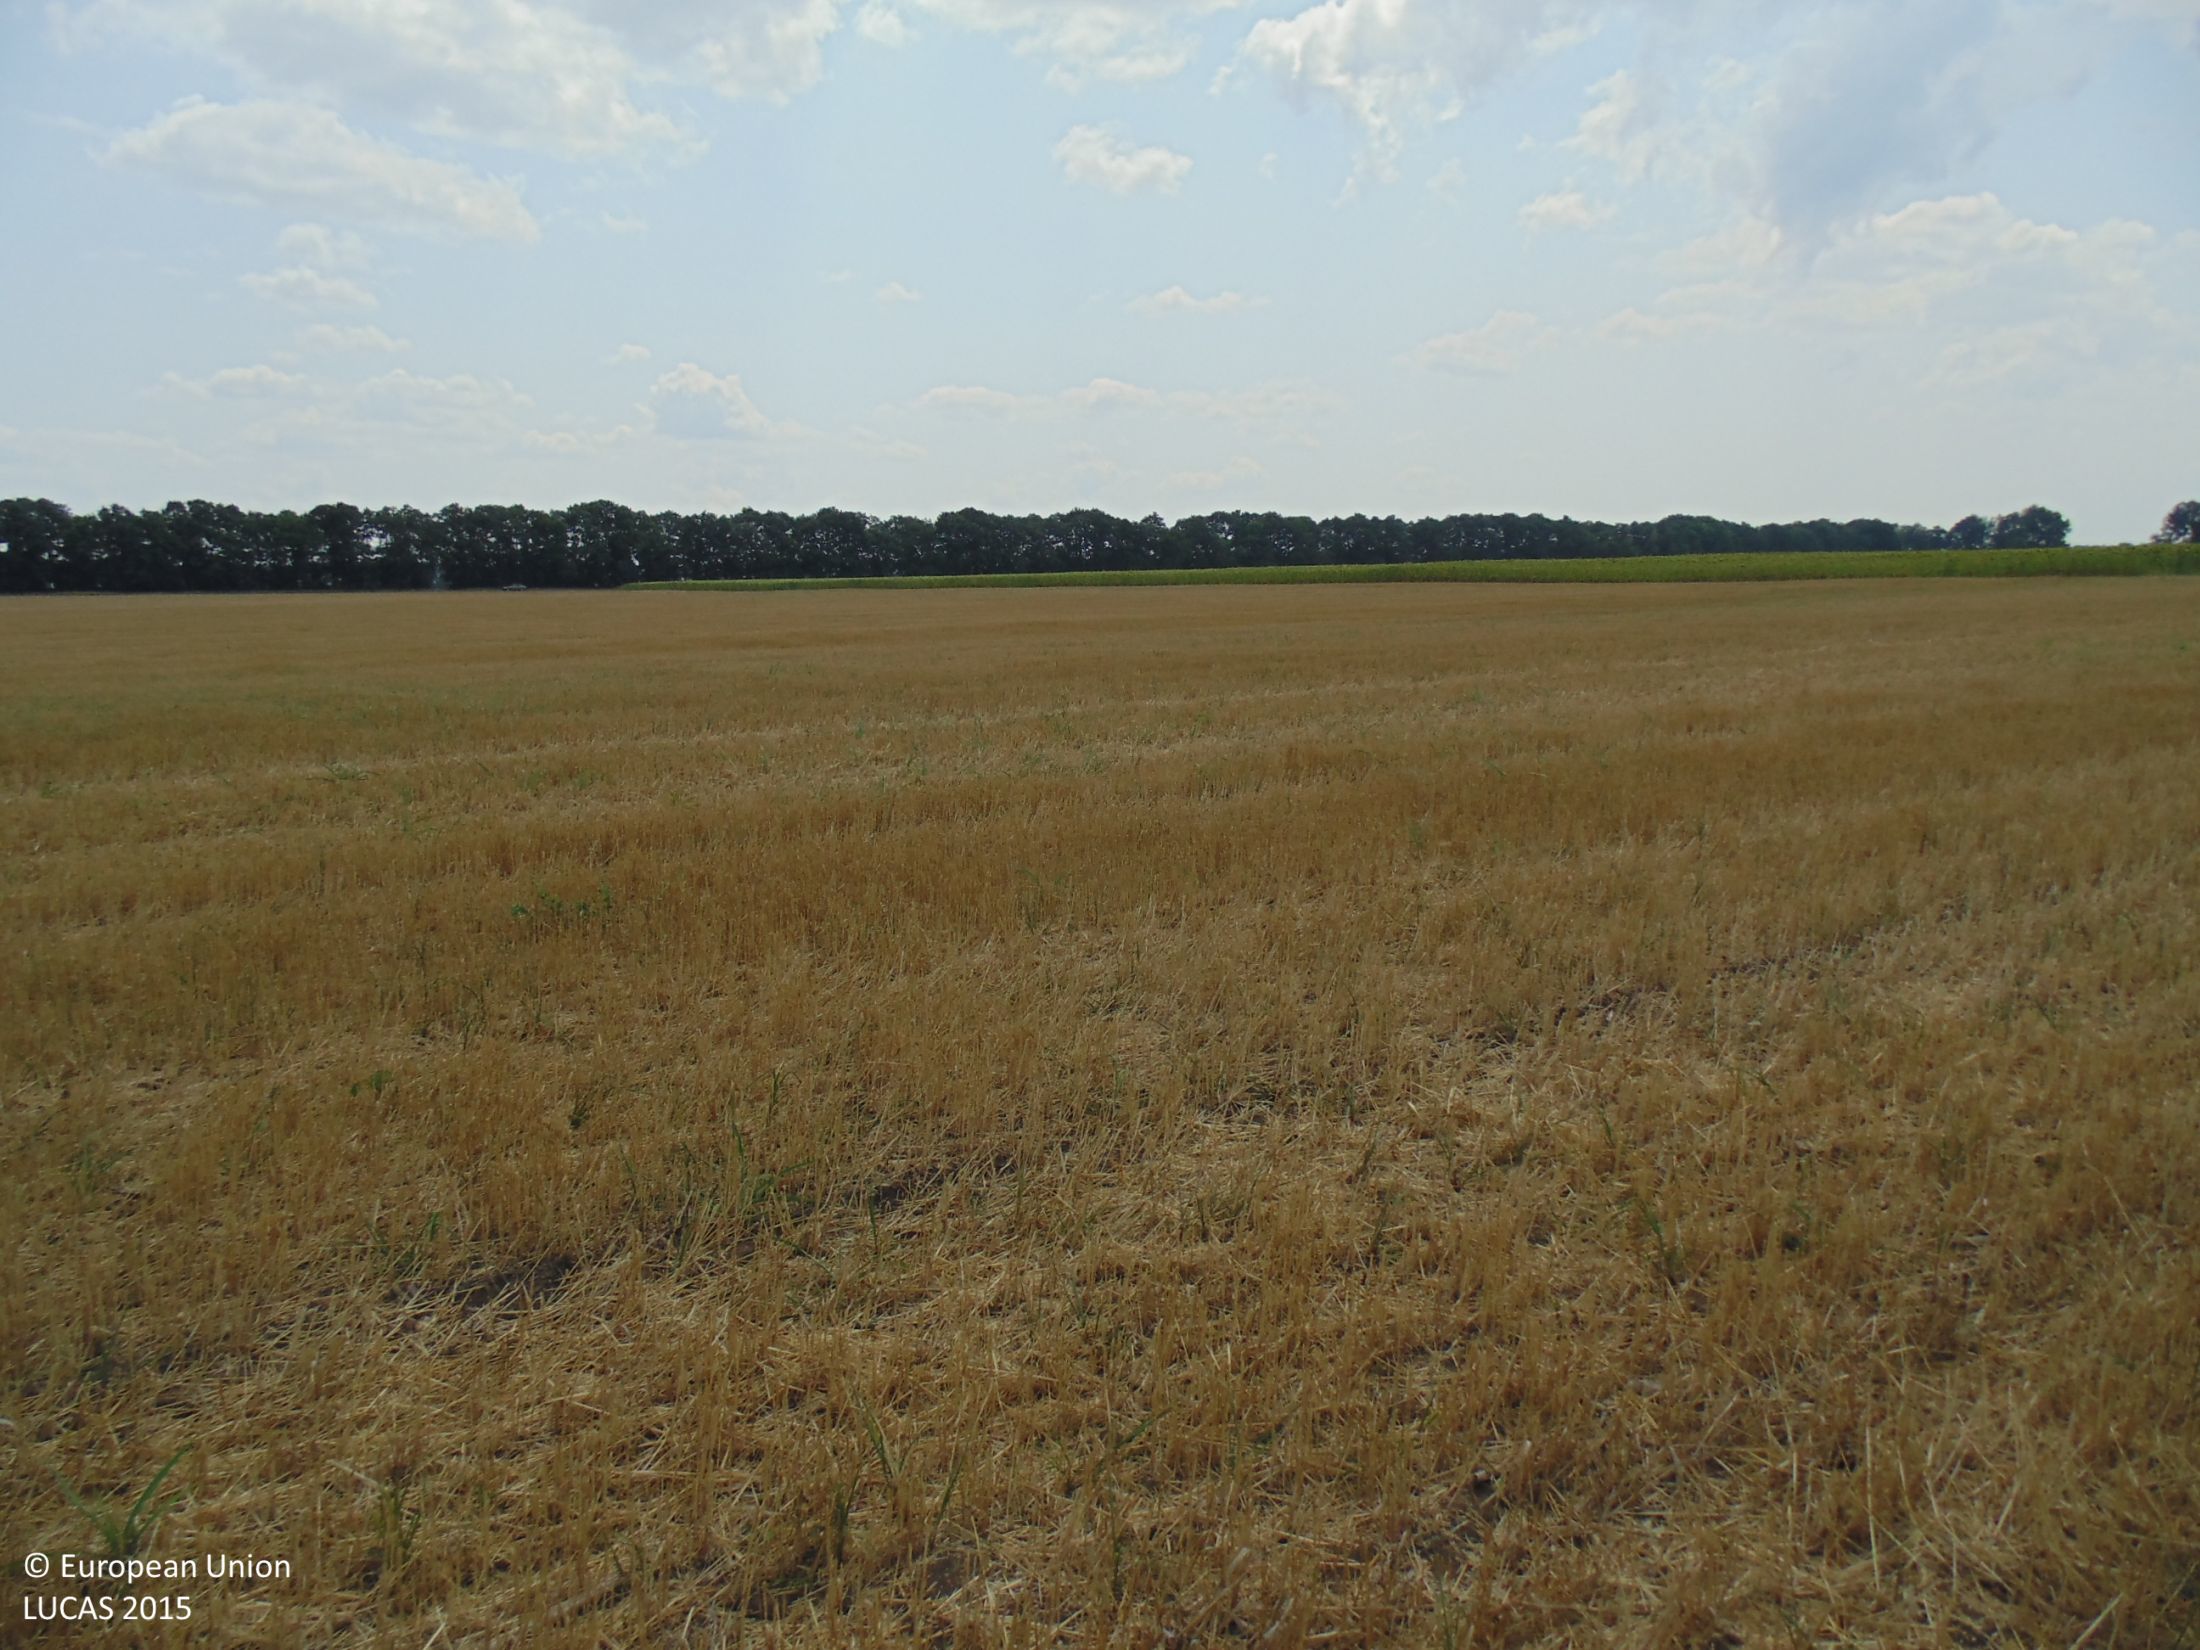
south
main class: Cropland
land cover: Common wheat
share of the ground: 25 - 50 %
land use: Agriculture (excluding fallow land and kitchen gardens)
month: July
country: BG
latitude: 43.7005
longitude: 28.0043
